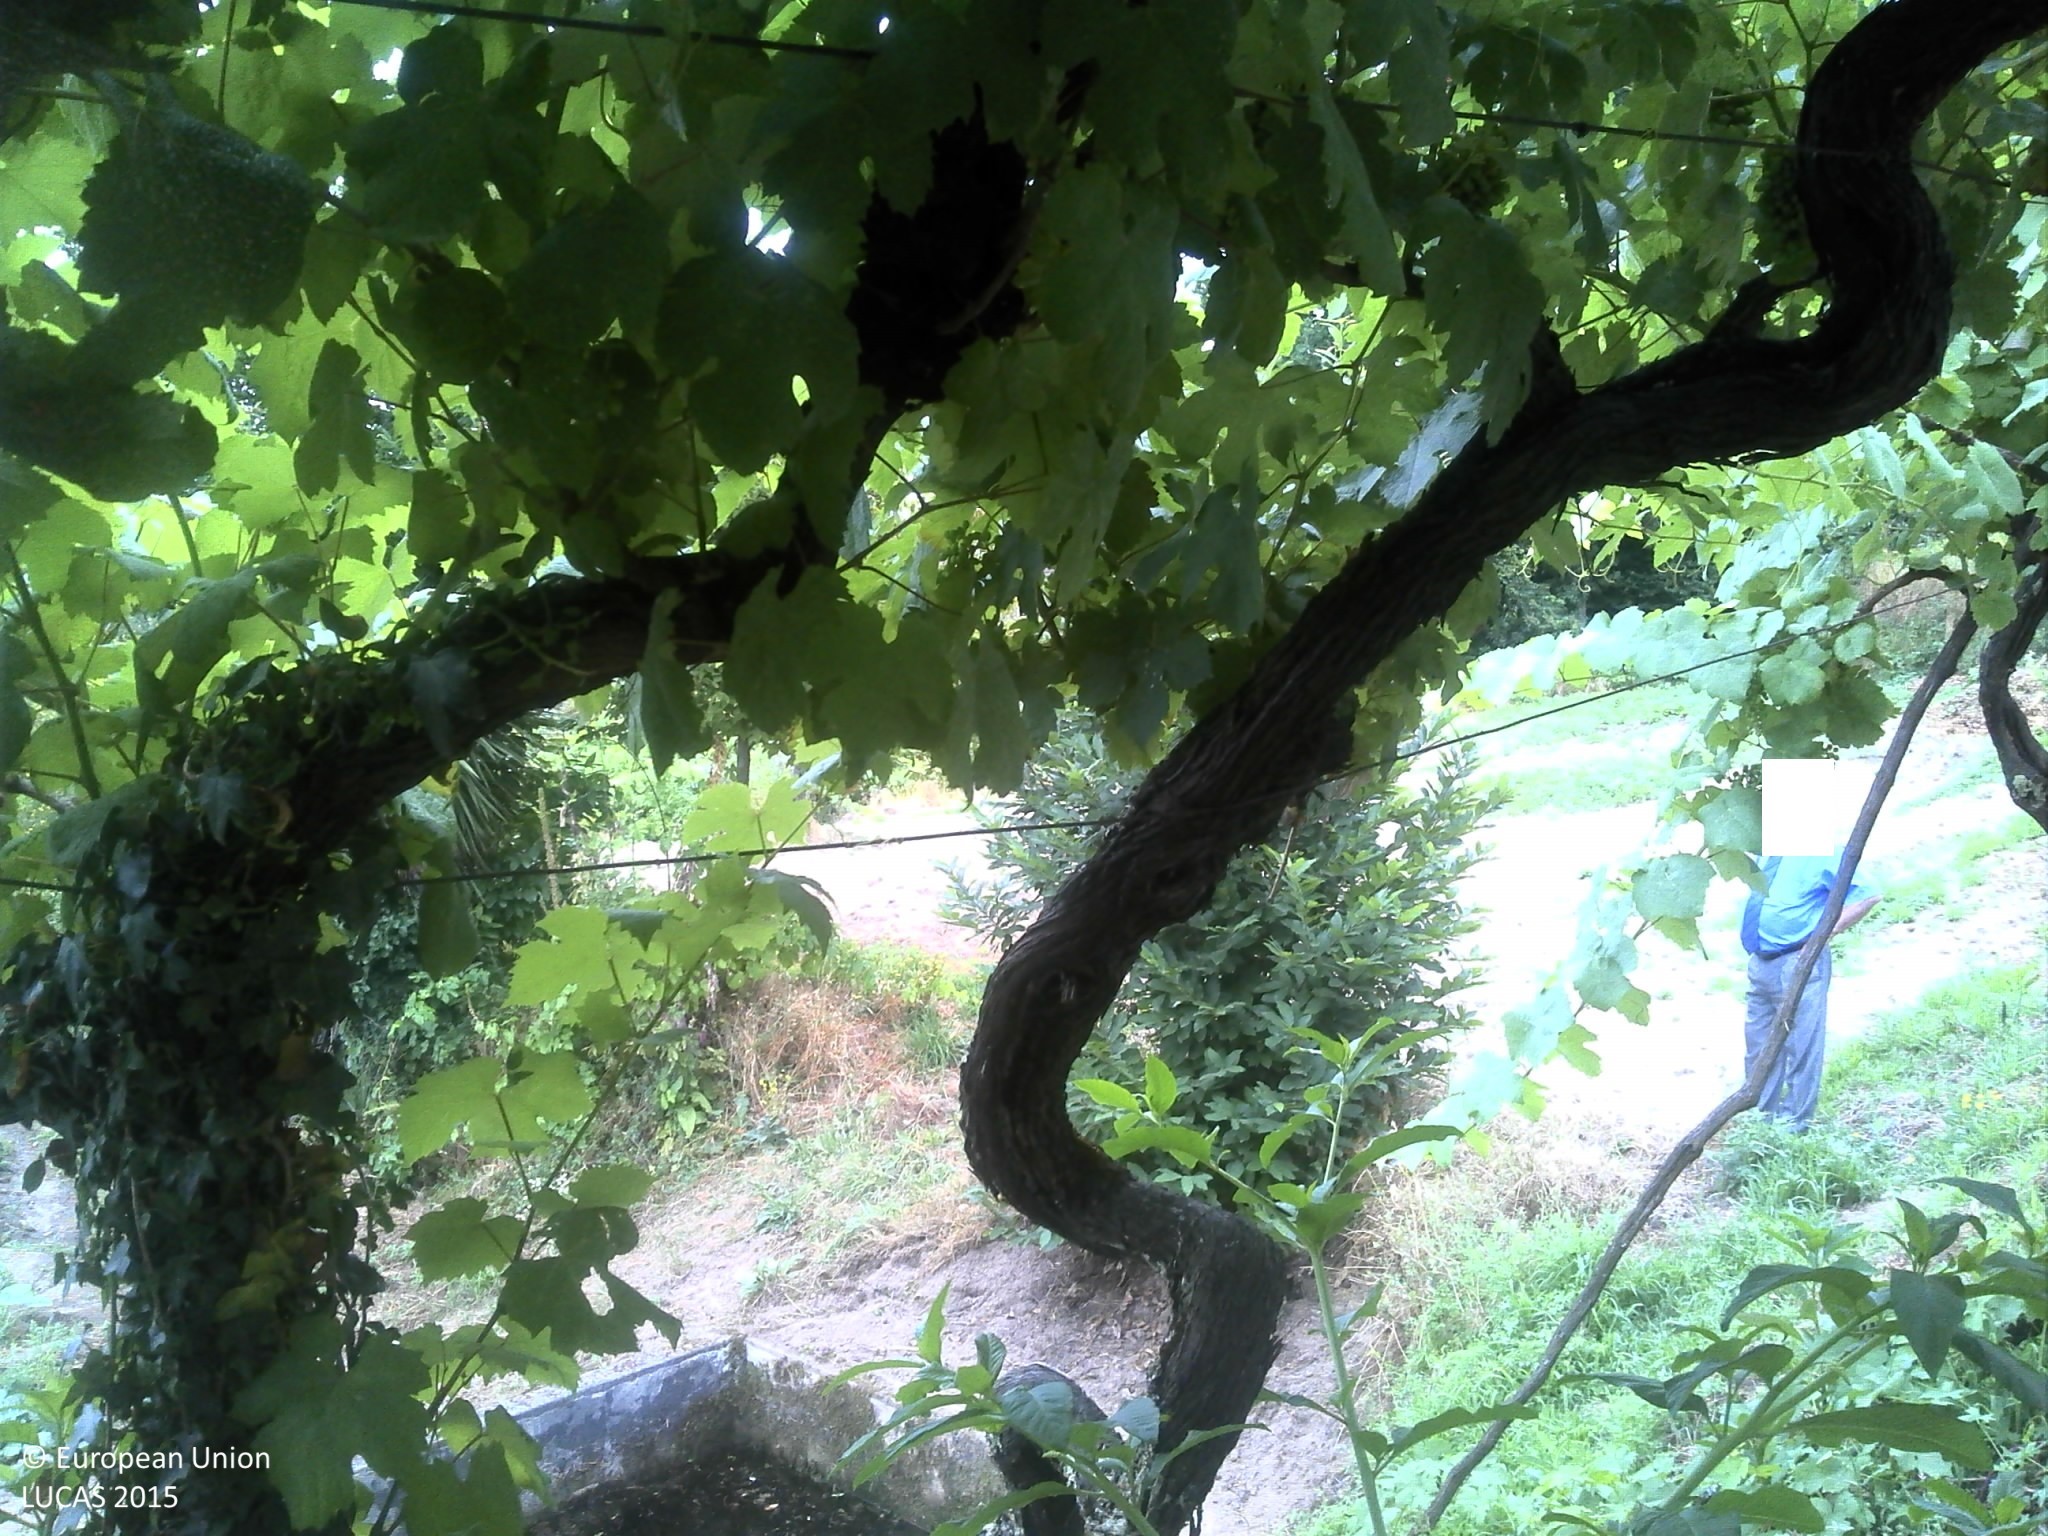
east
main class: Cropland
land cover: Vineyards
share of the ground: > 75 %
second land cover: Grassland without tree/shrub cover
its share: 10 - 25 %
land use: Agriculture (excluding fallow land and kitchen gardens)
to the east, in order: Vineyards; Grassland without tree/shrub cover; Vineyards; Grass margins; Inland fresh water bodies; Maize; Vineyards; Fences; Spontaneously vegetated surfaces; Electric lines; Spontaneously vegetated surfaces; Artificial constructions in urban areas; Vineyards; Dry stone walls; Shrubland without tree cover; Artificial constructions in urban areas; Broadleaved woodland; Electric lines; Broadleaved woodland; Artificial constructions in urban areas
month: June
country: PT
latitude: 41.2258
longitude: -8.2152
